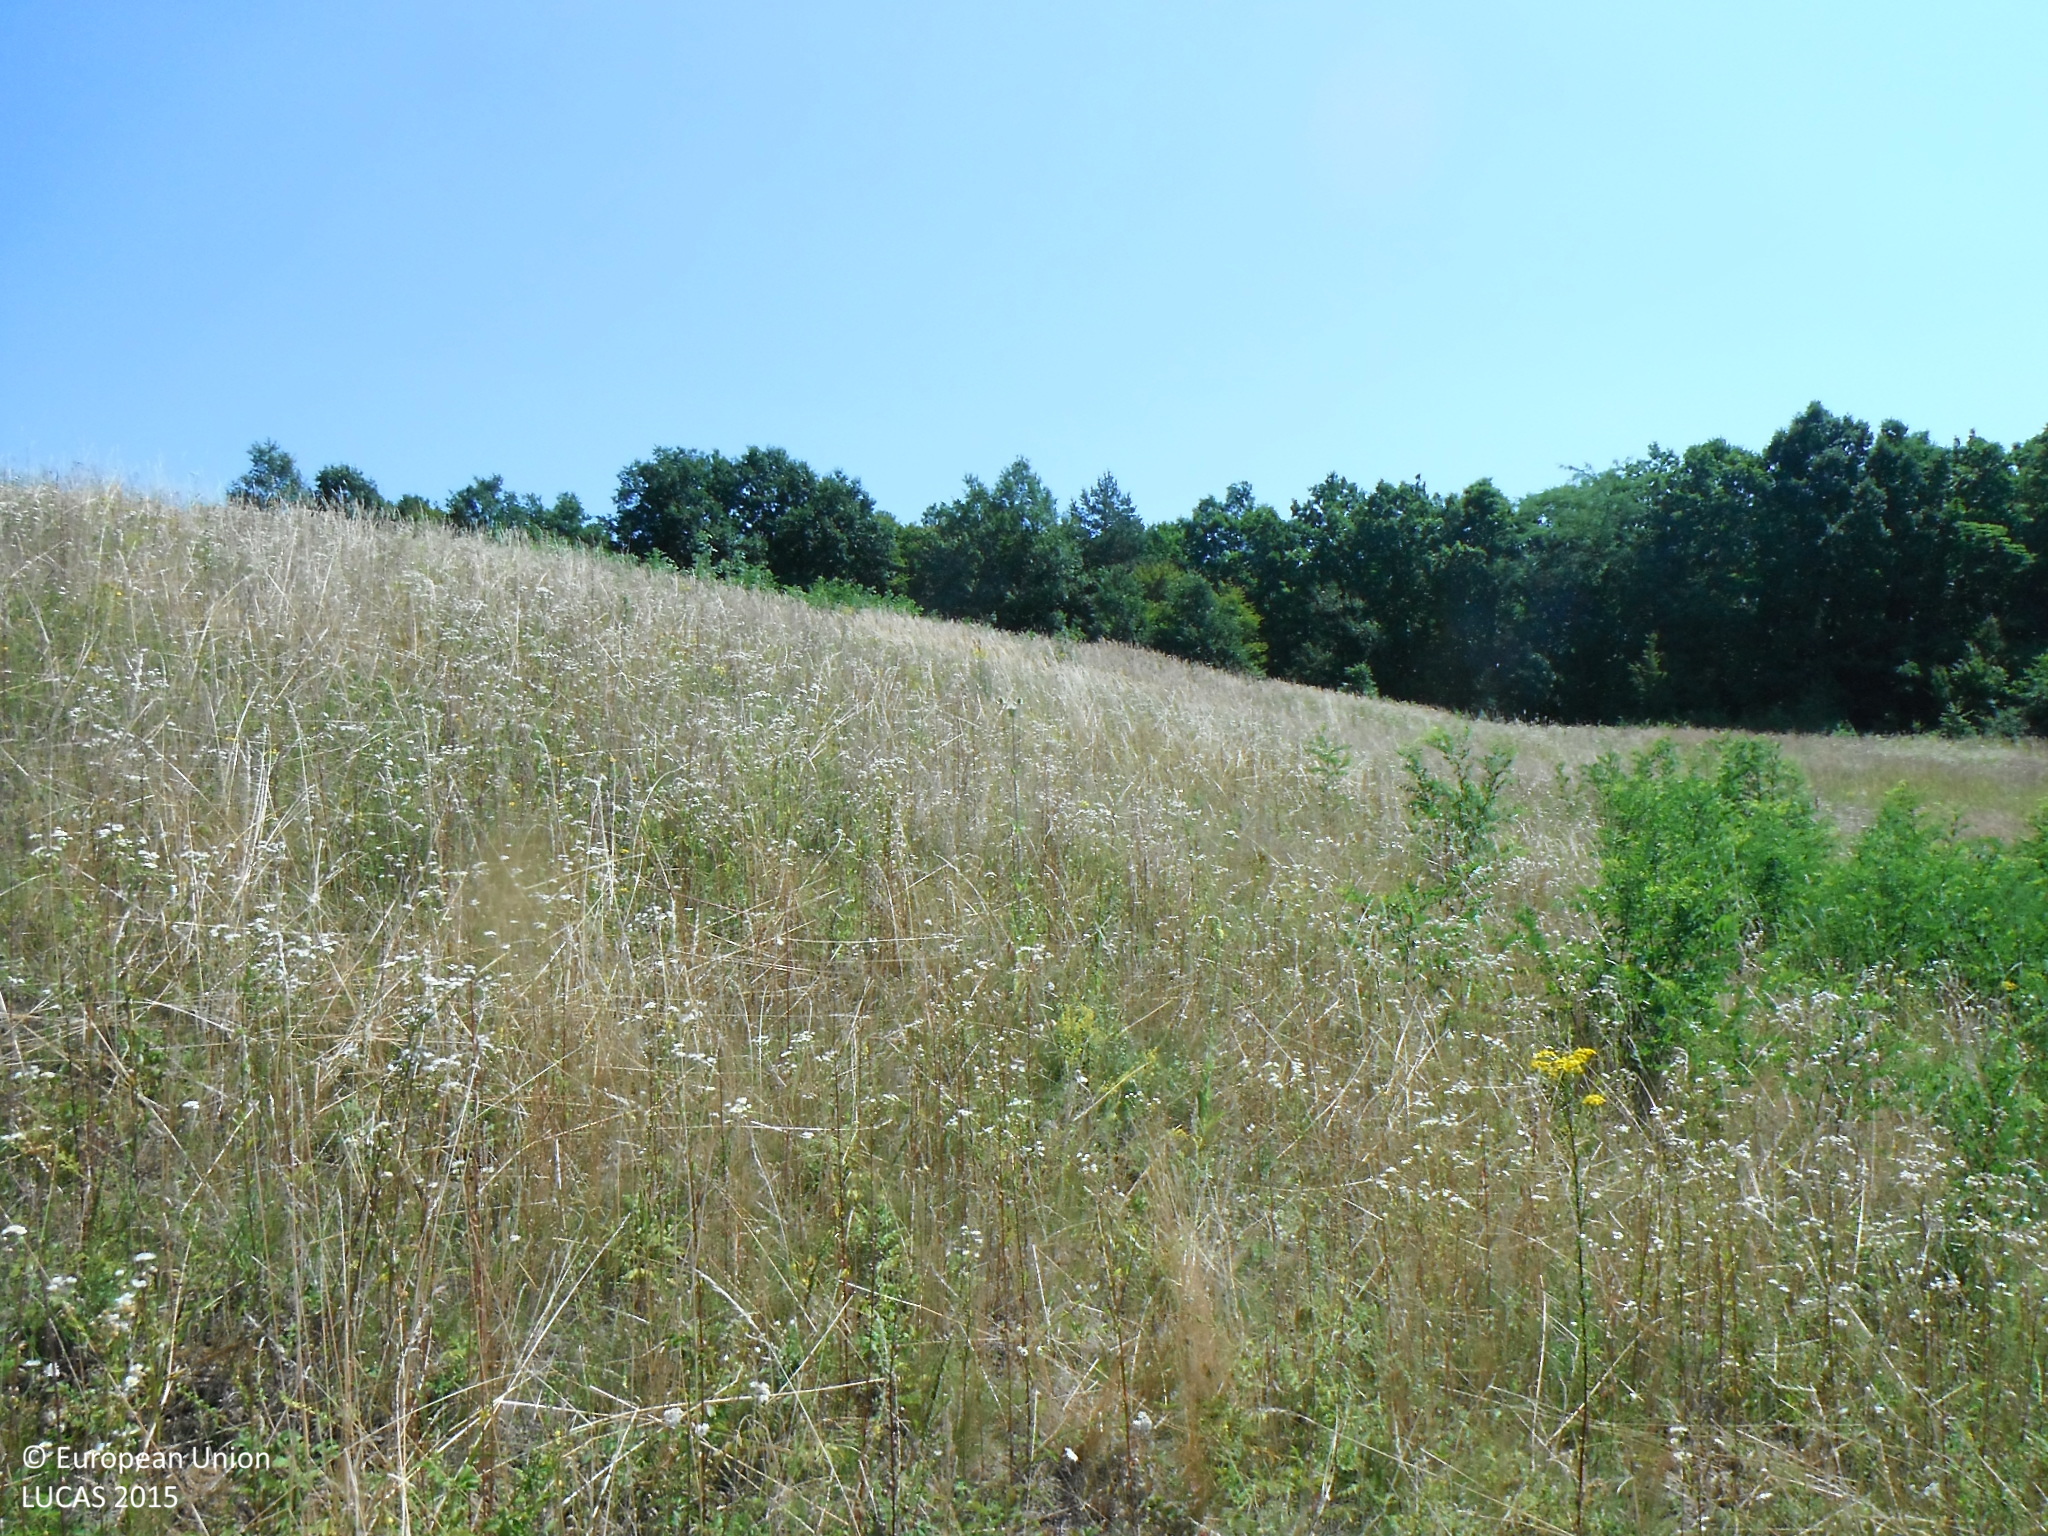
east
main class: Grassland
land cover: Spontaneously vegetated surfaces
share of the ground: > 75 %
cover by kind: herbaceous plants 100 %
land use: Fallow land
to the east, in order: Spontaneously vegetated surfaces; Shrubland without tree cover; Tracks; Spontaneously vegetated surfaces; Broadleaved woodland
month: July
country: SK
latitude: 48.2134
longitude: 20.0827
